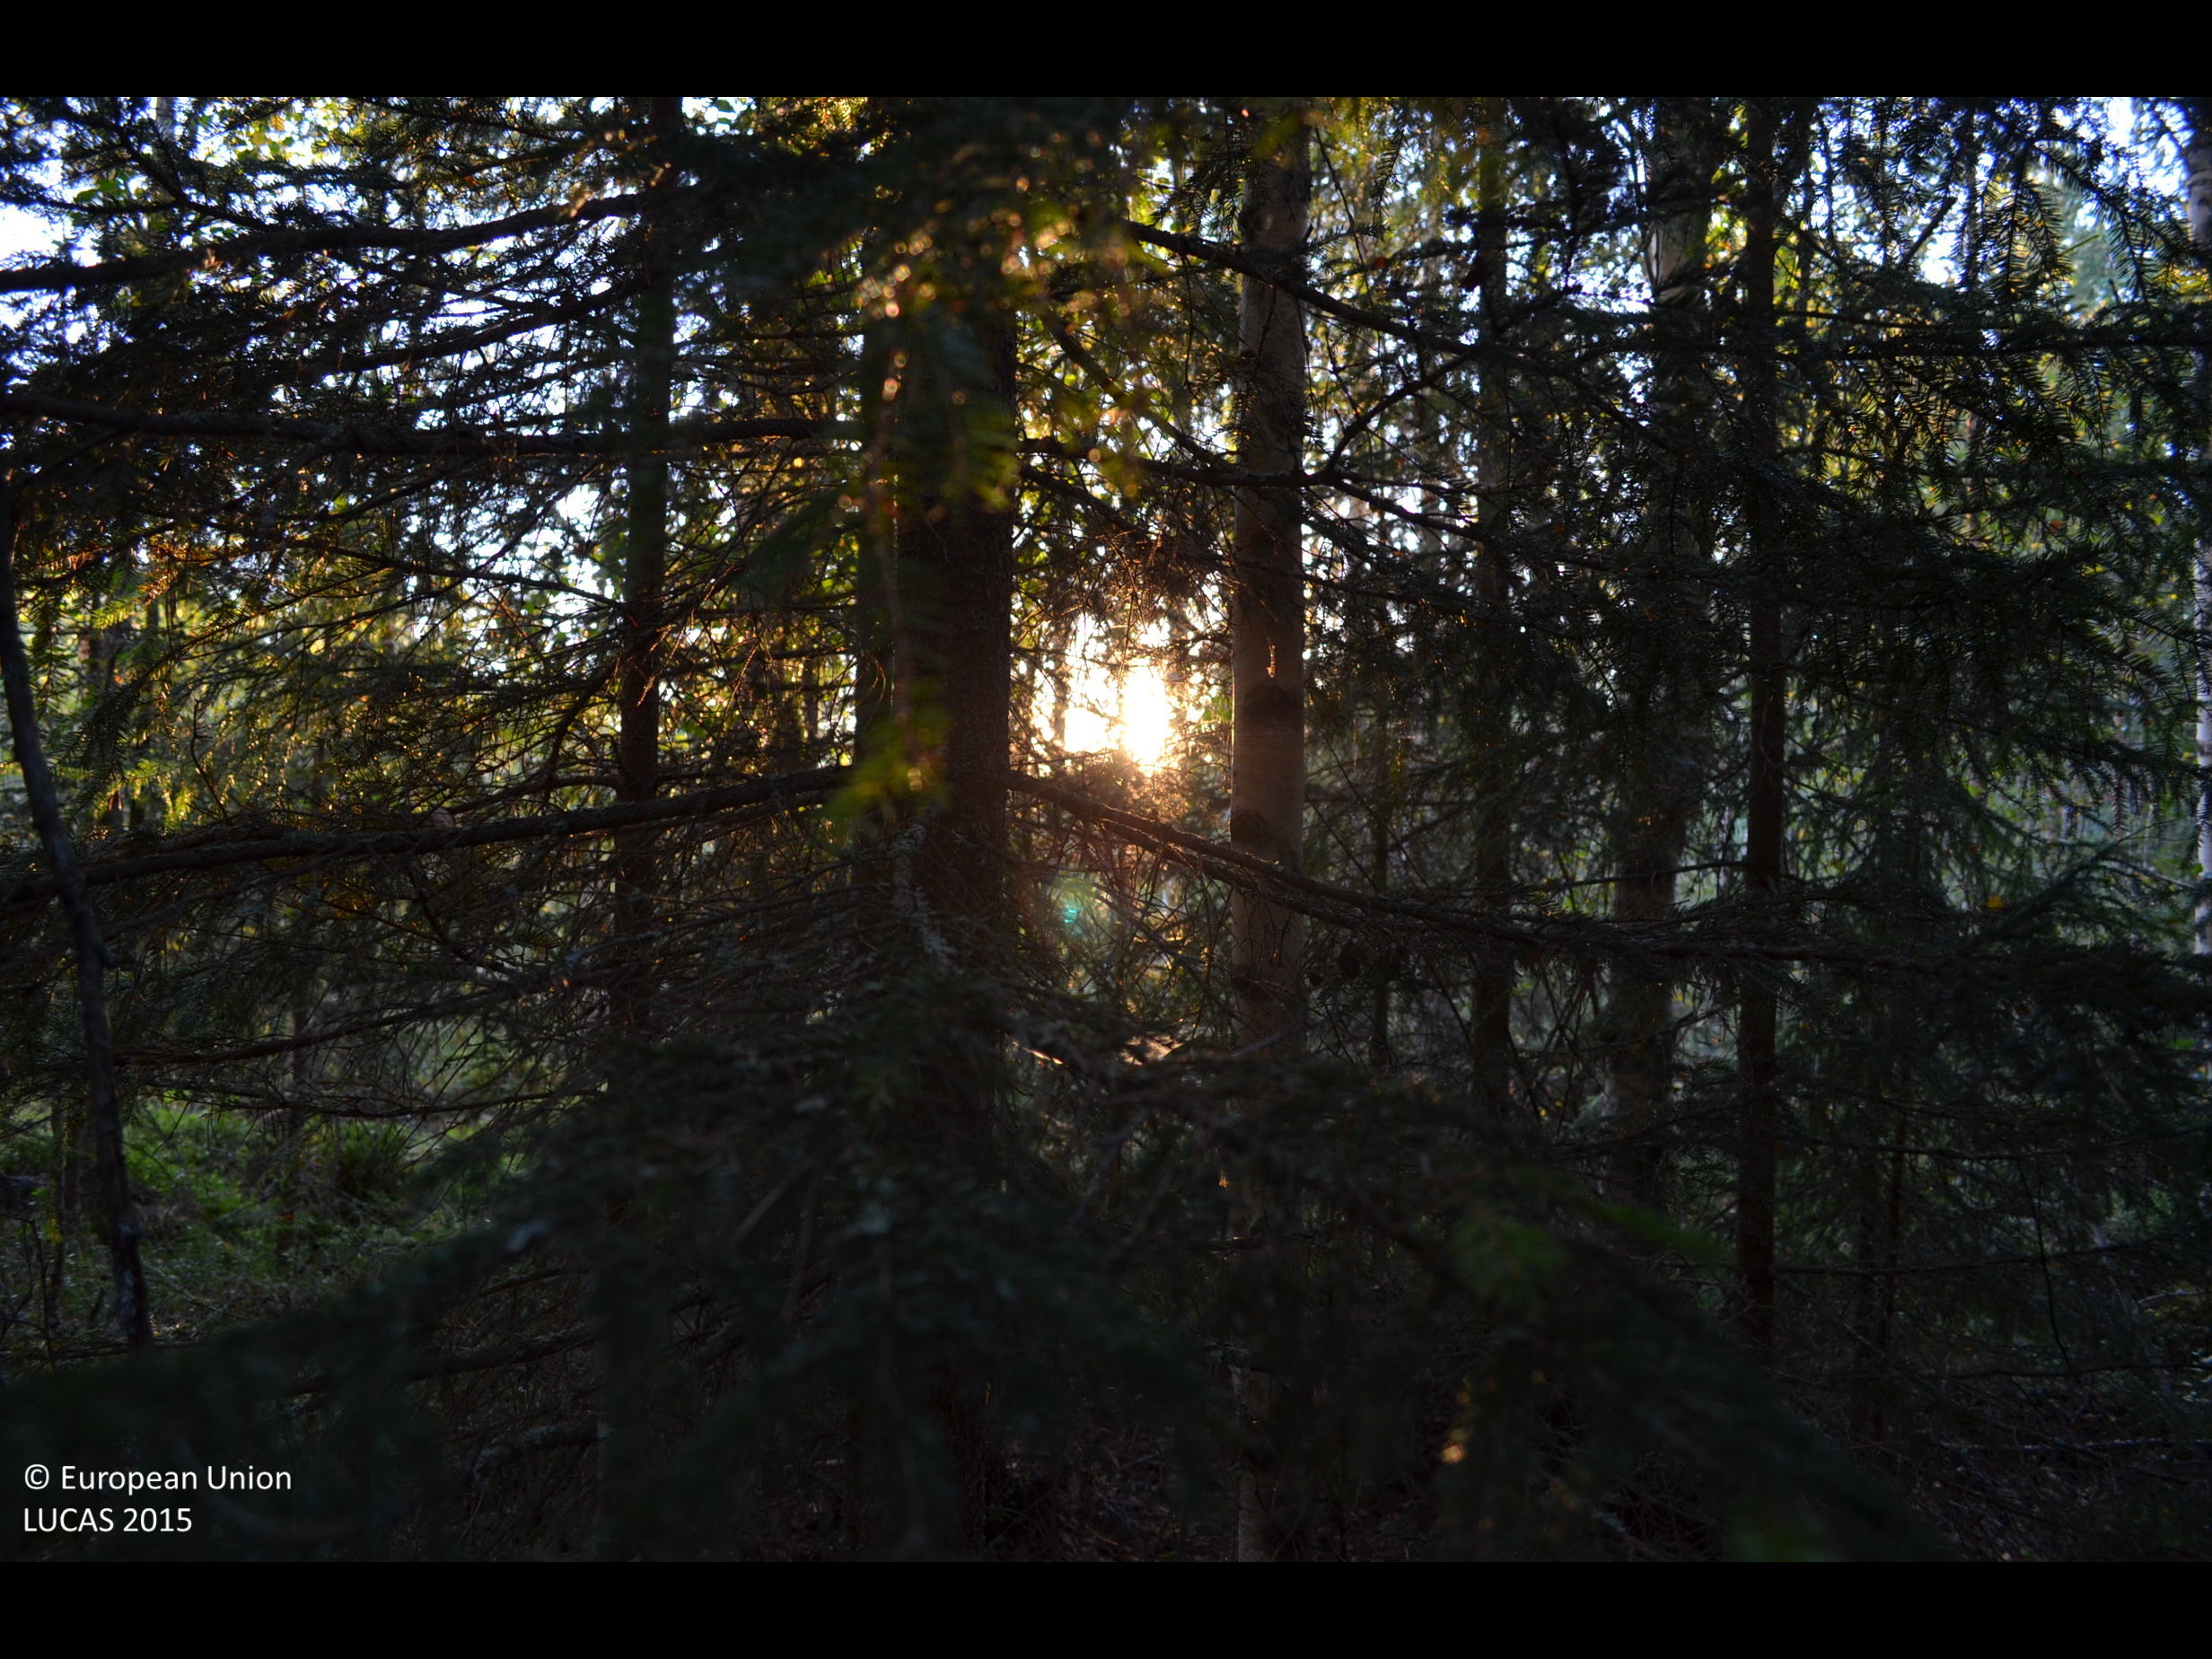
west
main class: Woodland
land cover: Other mixed woodland
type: boreal forest
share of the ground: > 75 %
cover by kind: coniferous forest trees 45 %, broadleaved forest trees 40 %, shrubs 5 %, herbaceous plants 5 %
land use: Forestry
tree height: > 5 m
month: August
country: FI
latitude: 62.4965
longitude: 24.4722
